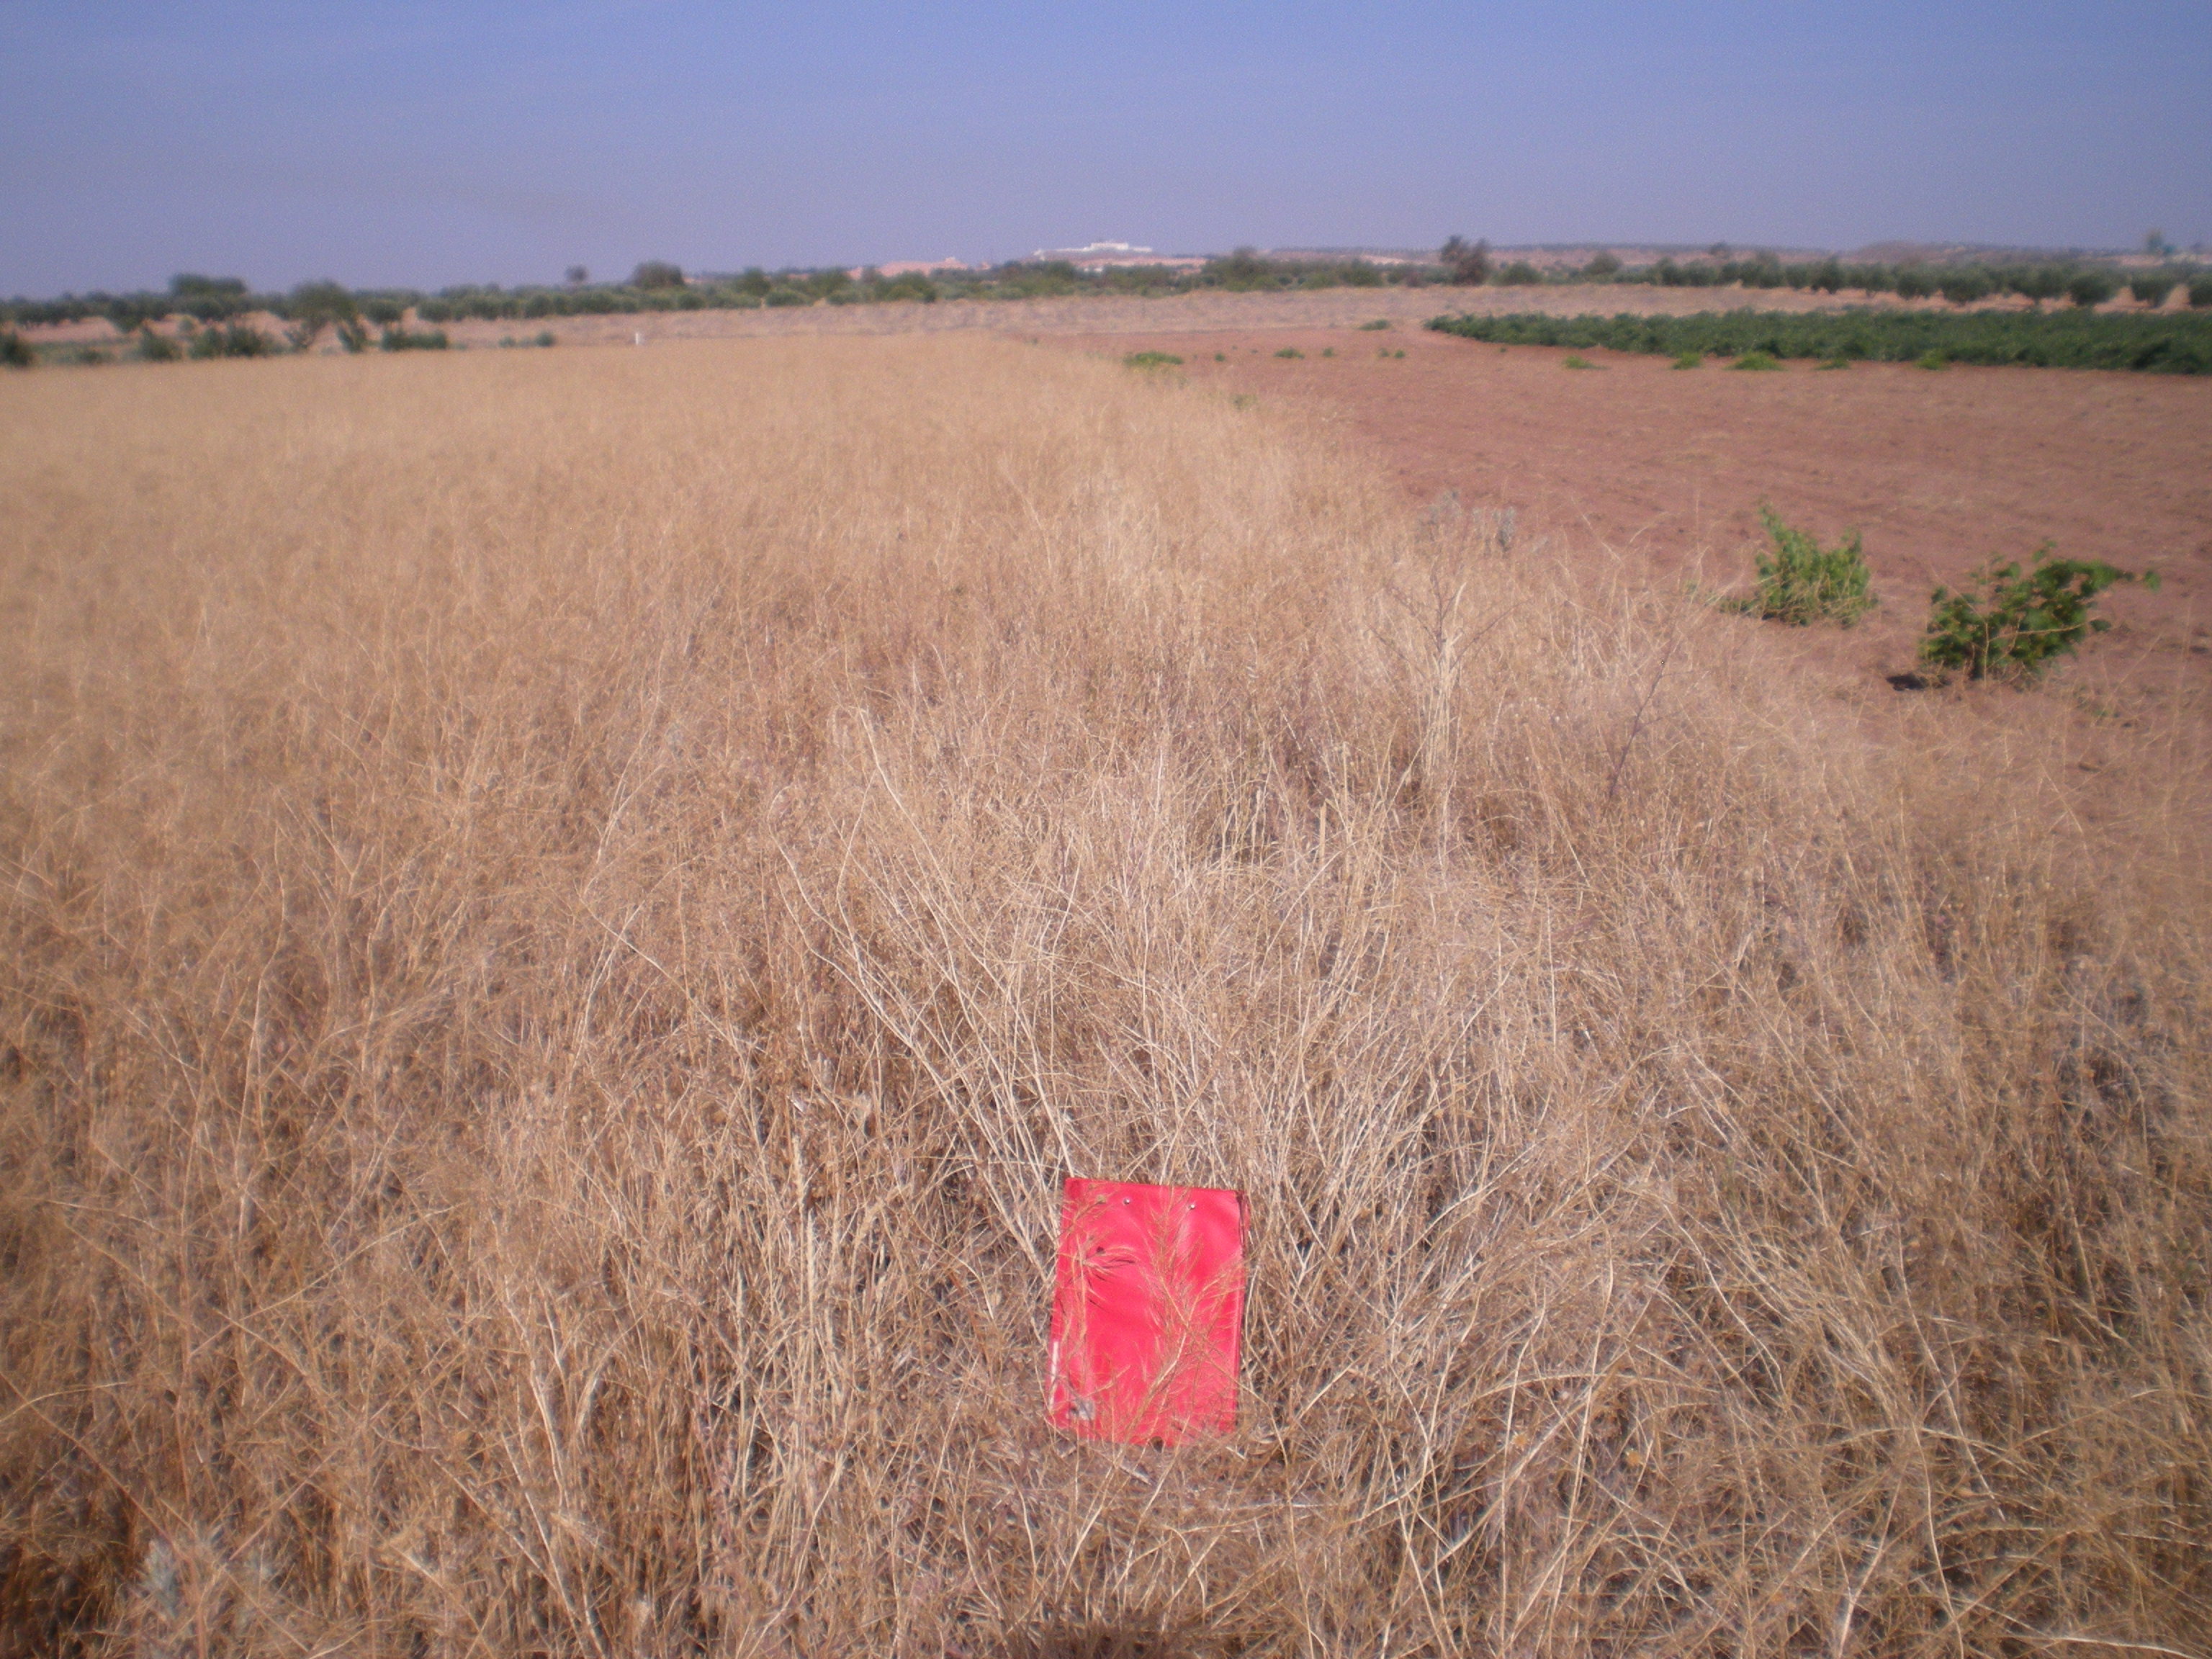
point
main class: Grassland
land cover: Spontaneously vegetated surfaces
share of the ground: 10 - 25 %
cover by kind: unconsolidated bare surface 85 %, herbaceous plants 15 %
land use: Fallow land
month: July
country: ES
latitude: 39.4087
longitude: -3.0588
